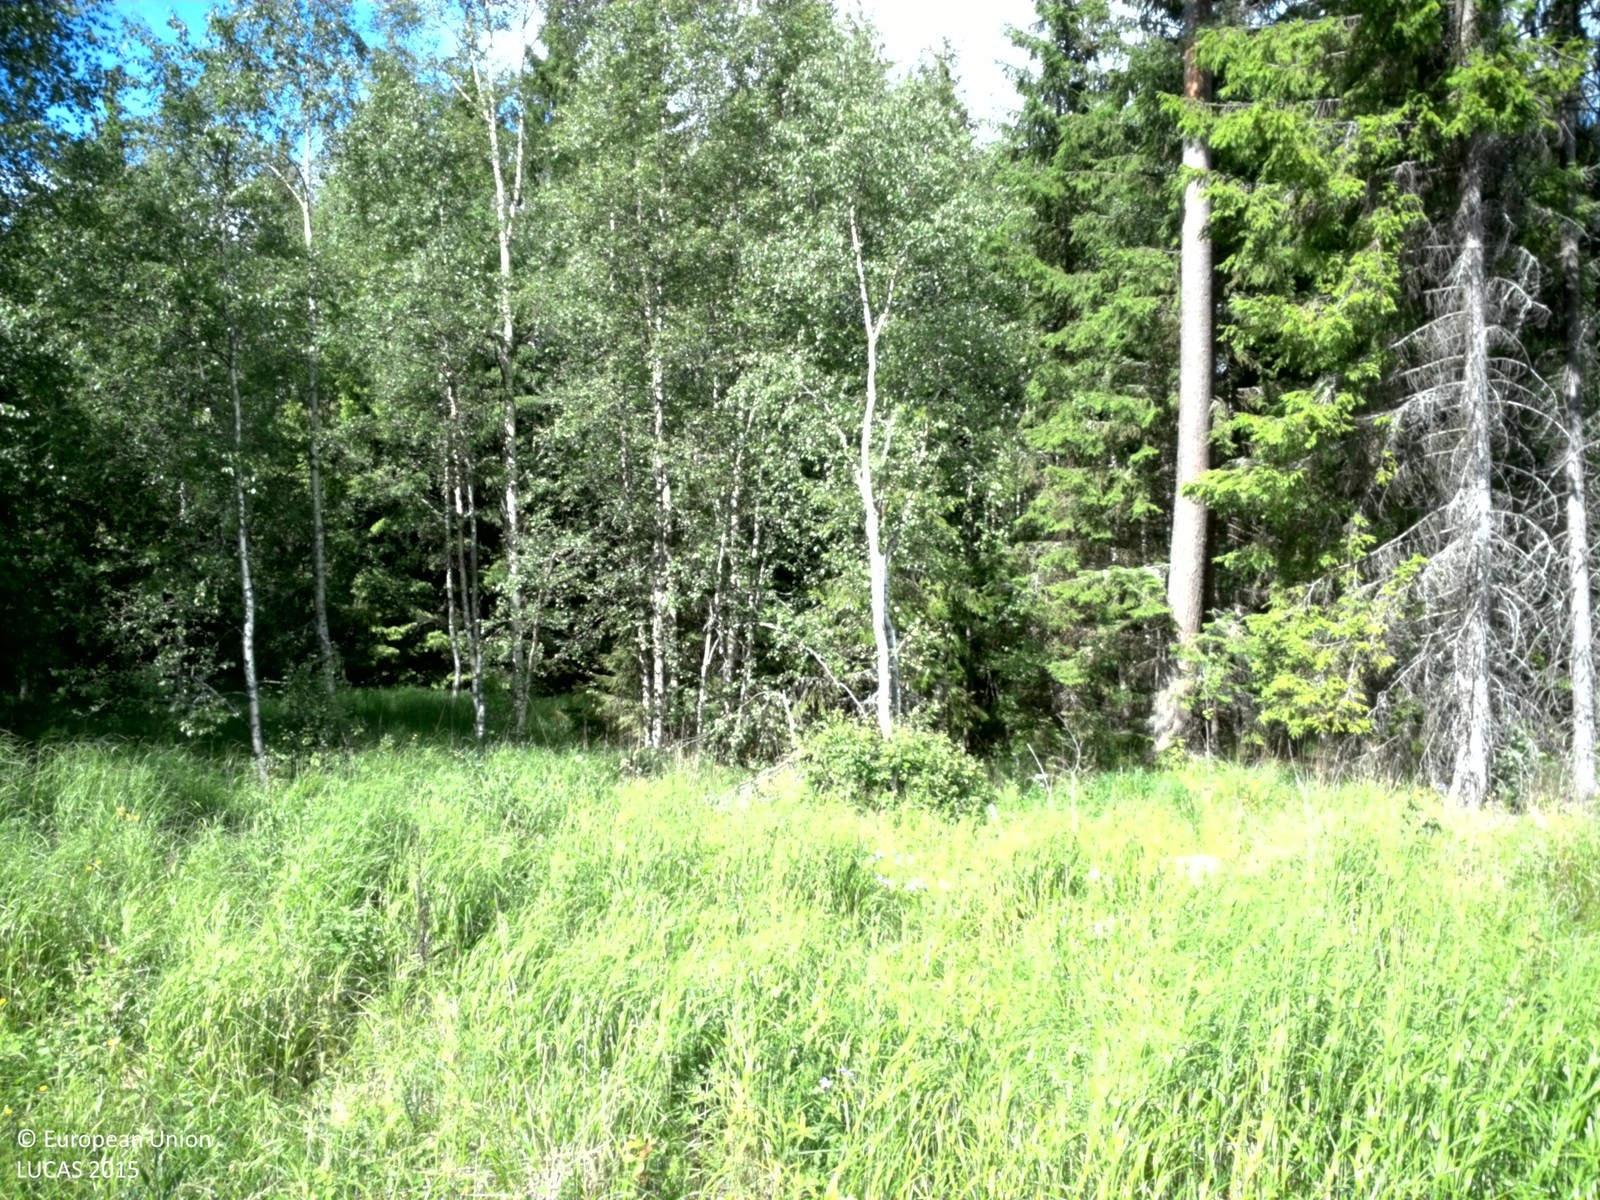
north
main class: Grassland
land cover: Grassland with sparse tree/shrub cover
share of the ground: < 10 %
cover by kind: herbaceous plants 80 %, unconsolidated bare surface 15 %, broadleaved forest trees 5 %
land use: Forestry
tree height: > 5 m
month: June
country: SE
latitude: 60.1838
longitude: 17.0770
